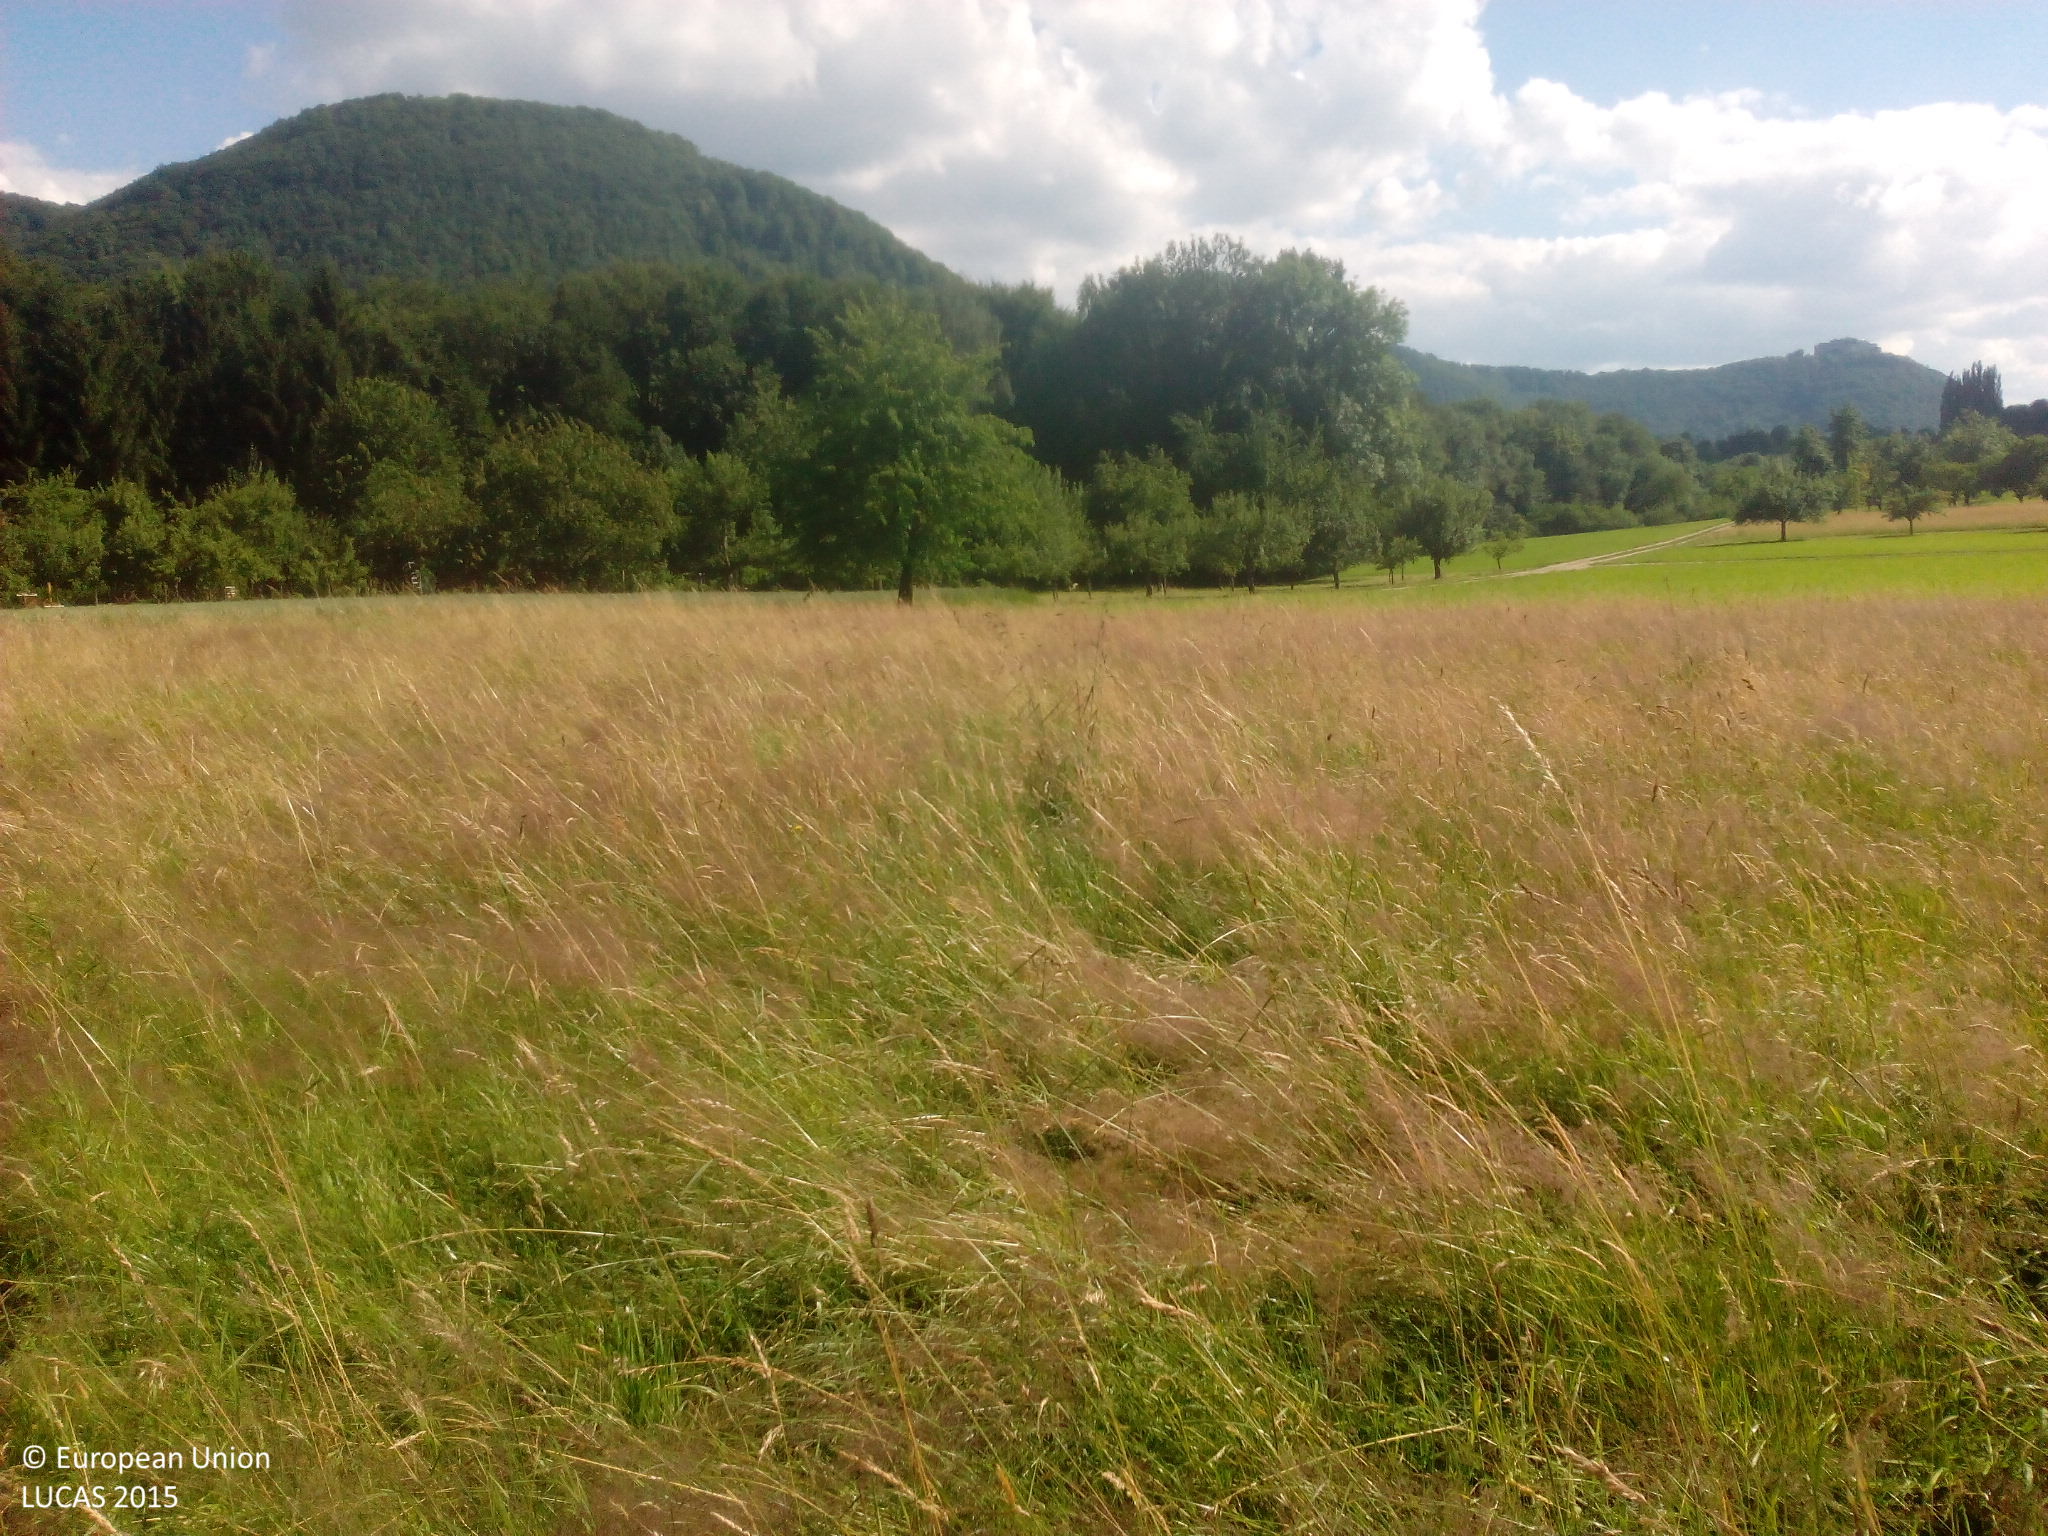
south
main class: Grassland
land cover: Grassland without tree/shrub cover
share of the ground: > 75 %
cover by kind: herbaceous plants 100 %
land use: Agriculture (excluding fallow land and kitchen gardens)
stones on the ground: < 10 %
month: June
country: DE
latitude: 48.5819
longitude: 9.4174
